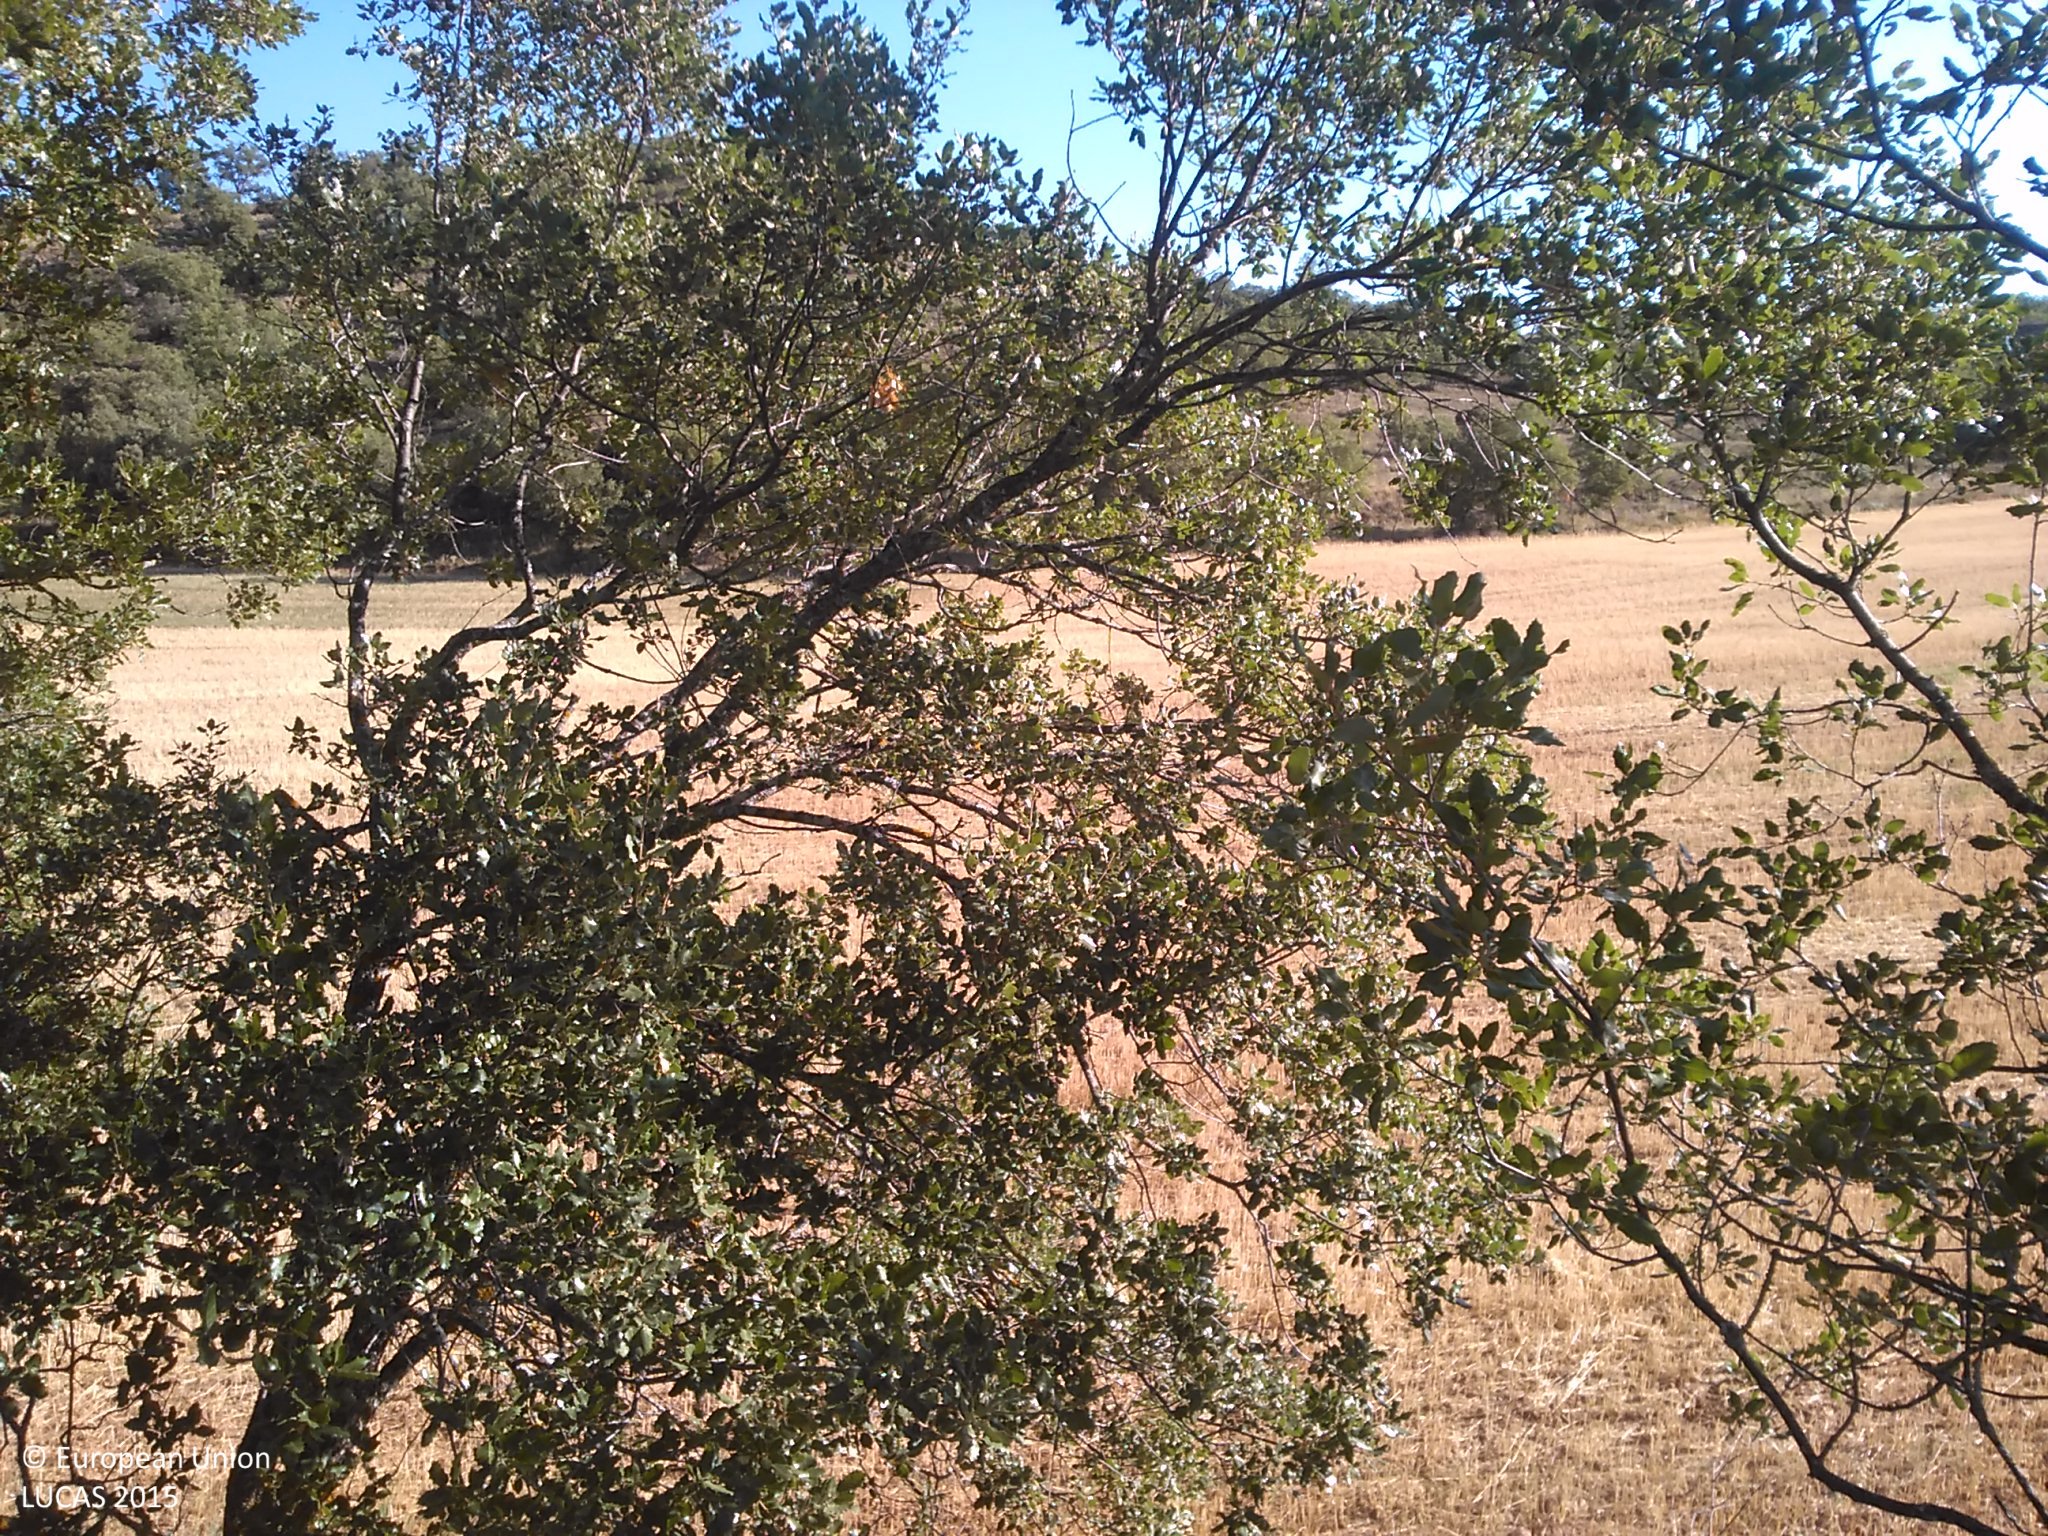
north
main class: Woodland
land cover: Broadleaved woodland
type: broadleaved evergreen forest
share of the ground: 25 - 50 %
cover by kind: broadleaved forest trees 40 %, herbaceous plants 35 %, unconsolidated bare surface 20 %, shrubs 5 %
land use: Semi-natural and natural areas not in use
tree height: > 5 m
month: July
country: ES
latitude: 41.5008
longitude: -2.1431
